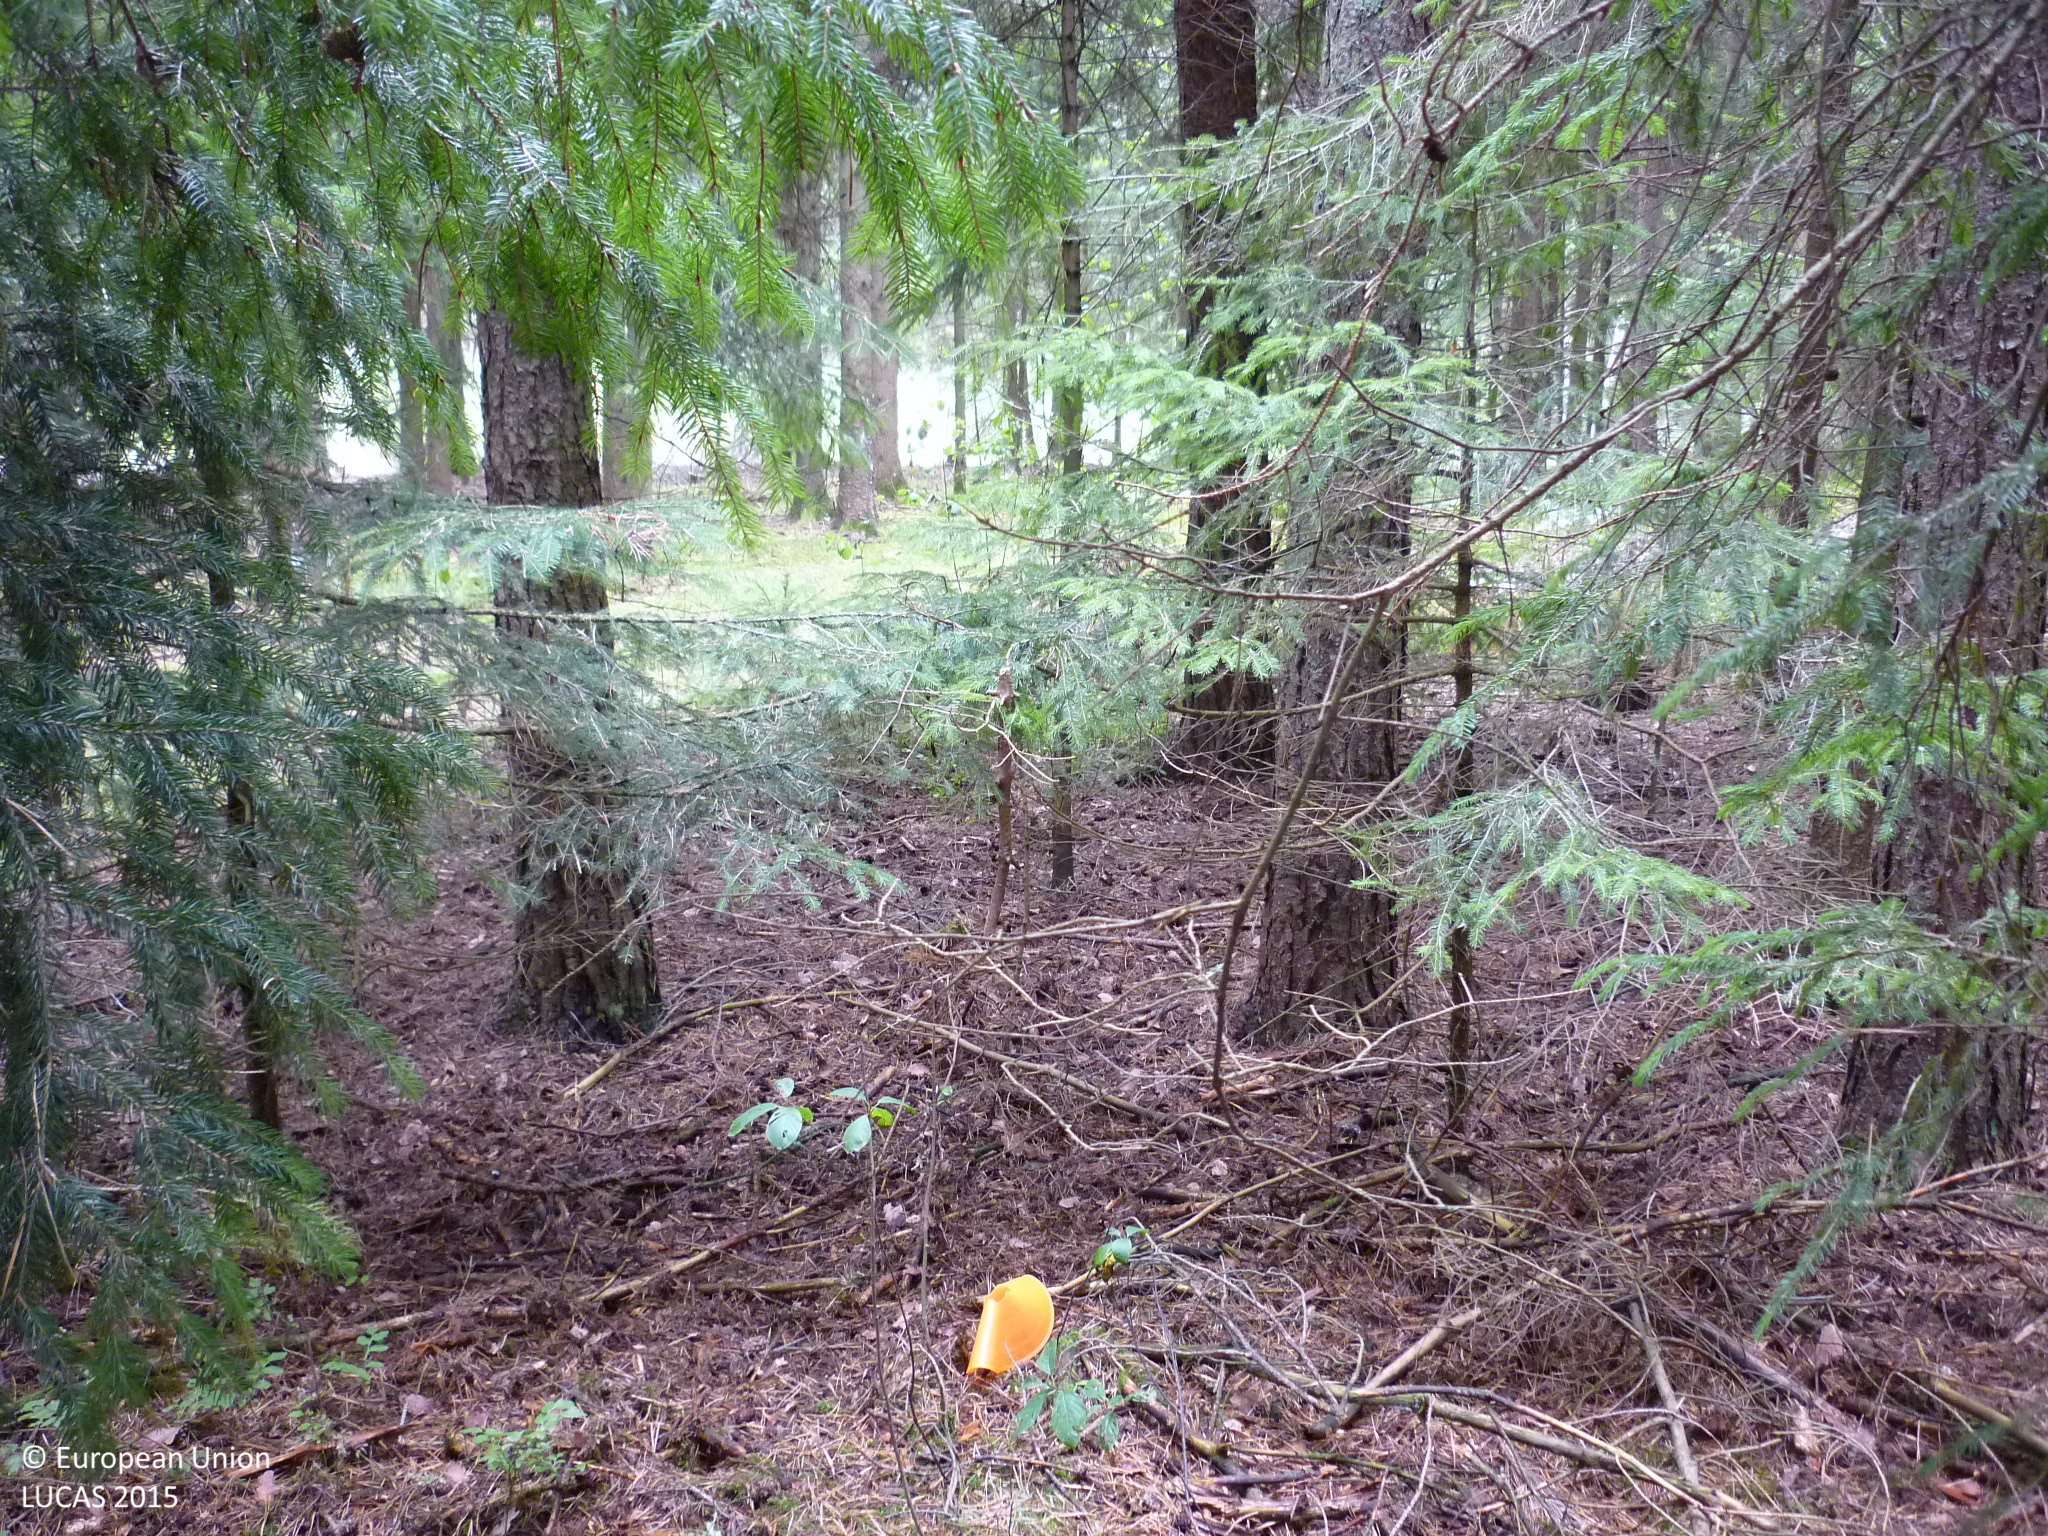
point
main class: Woodland
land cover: Spruce dominated coniferous woodland
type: hemiboreal forest and nemoral coniferous forest and mixed broadleaved-coniferous forest
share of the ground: > 75 %
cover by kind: coniferous forest trees 95 %, lichens and mosses 5 %
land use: Forestry
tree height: > 5 m
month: September
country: AT
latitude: 48.8837
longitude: 15.0342
